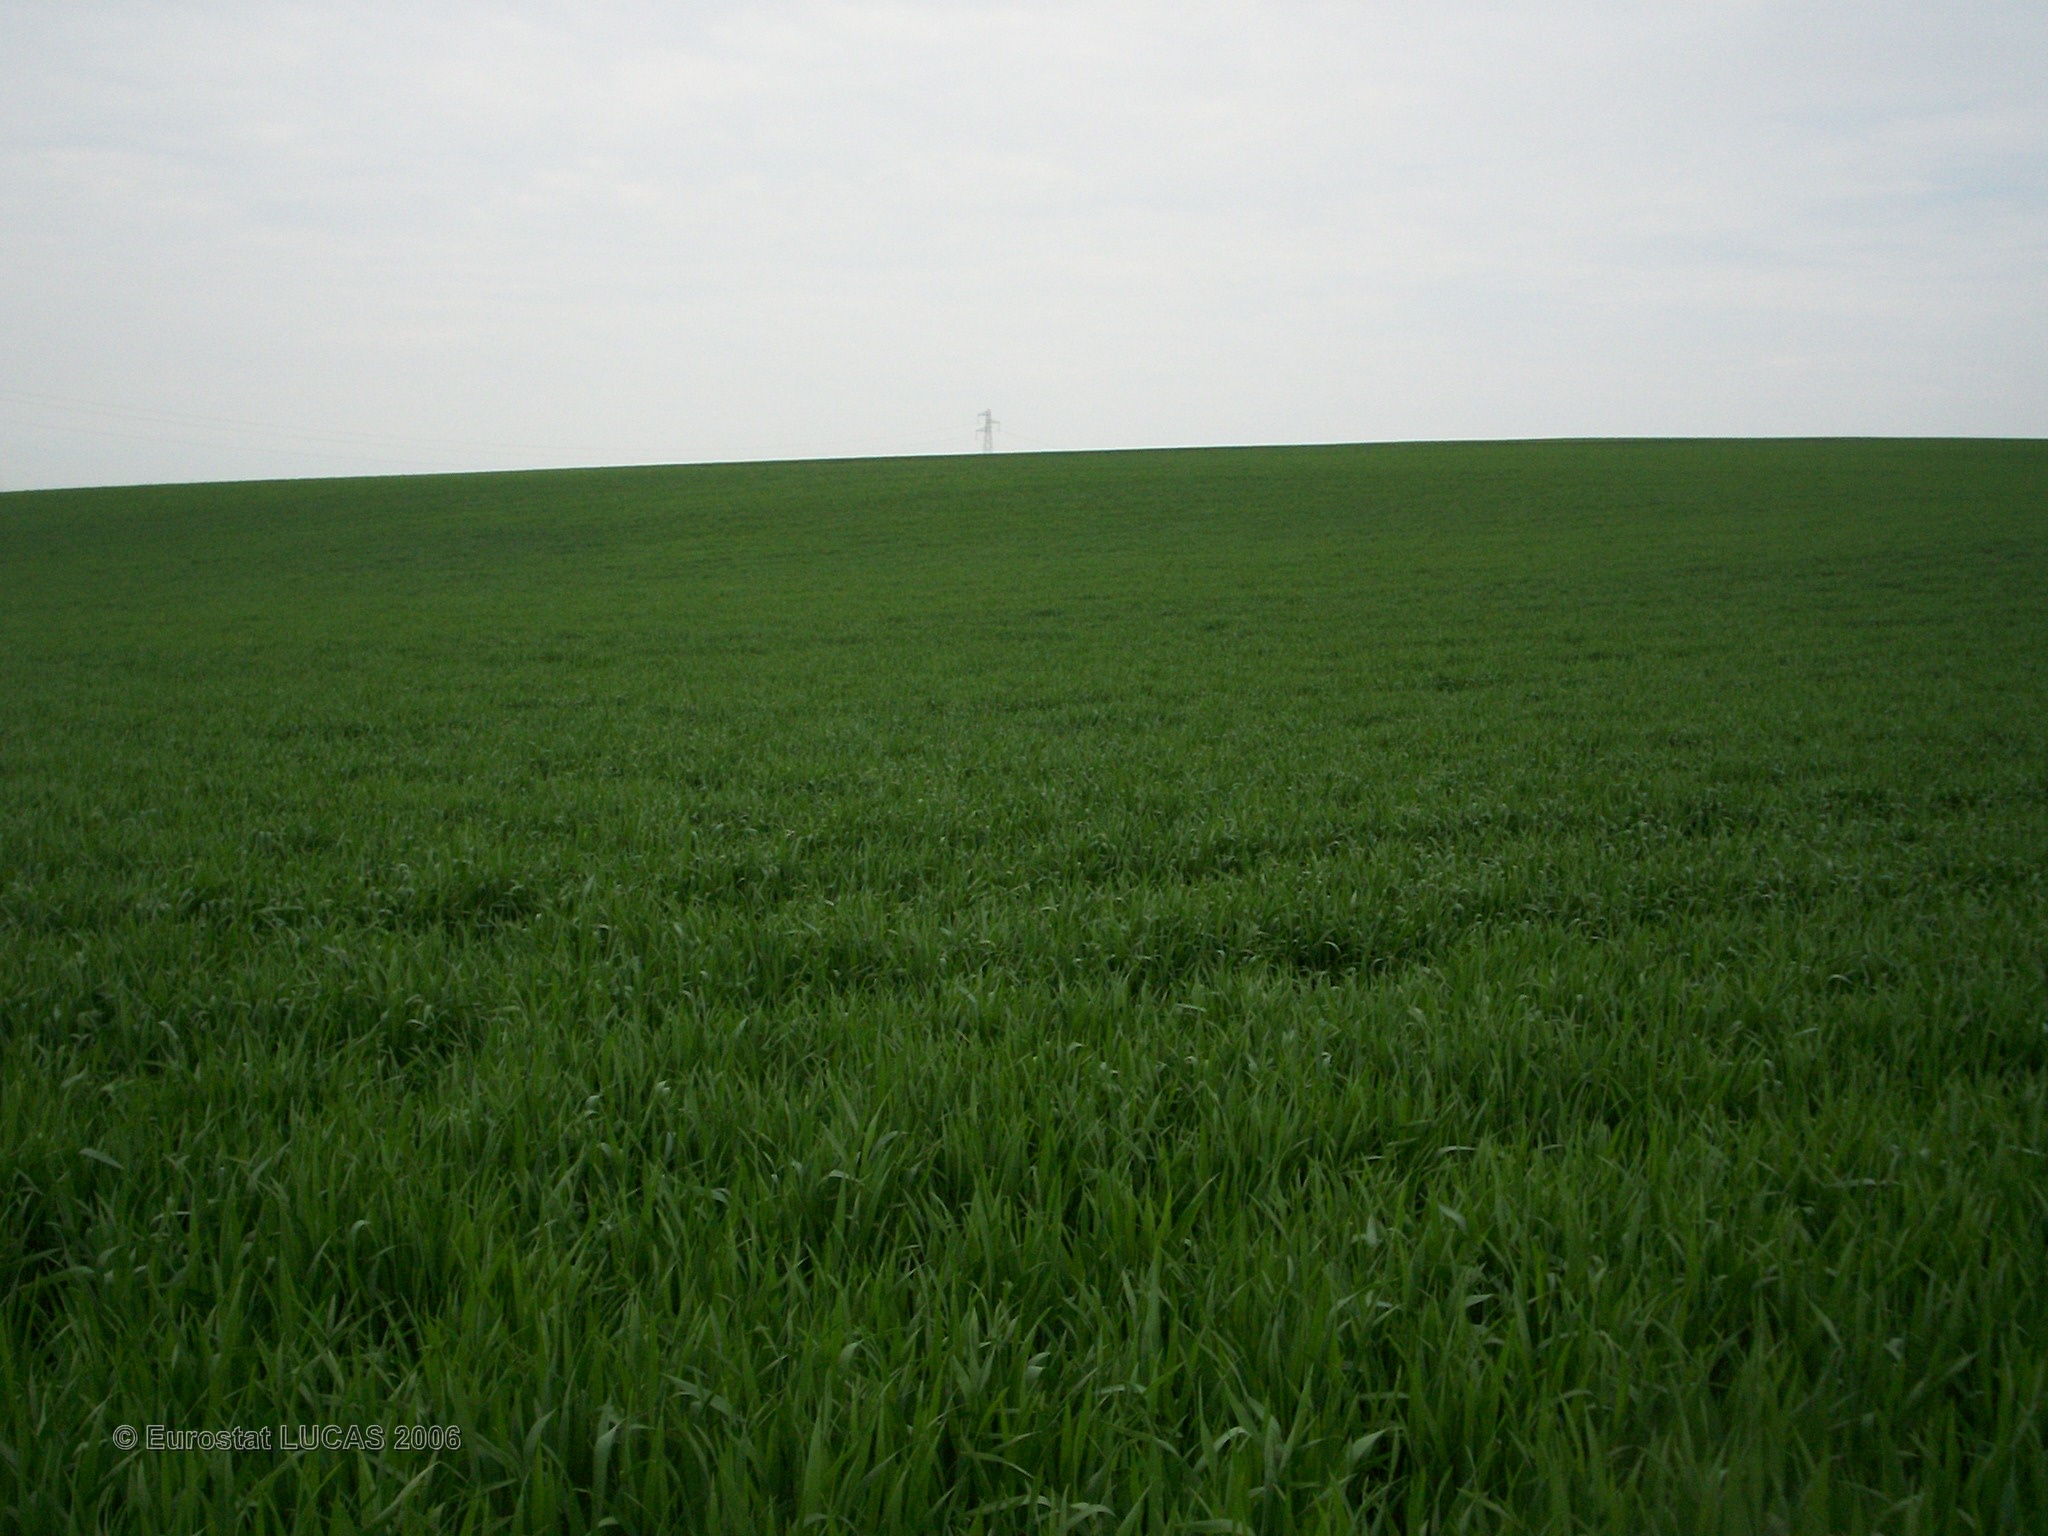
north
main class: Cropland
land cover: Common wheat
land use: Agriculture (excluding fallow land and kitchen gardens)
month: May
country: FR
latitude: 47.8240
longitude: 3.9728
